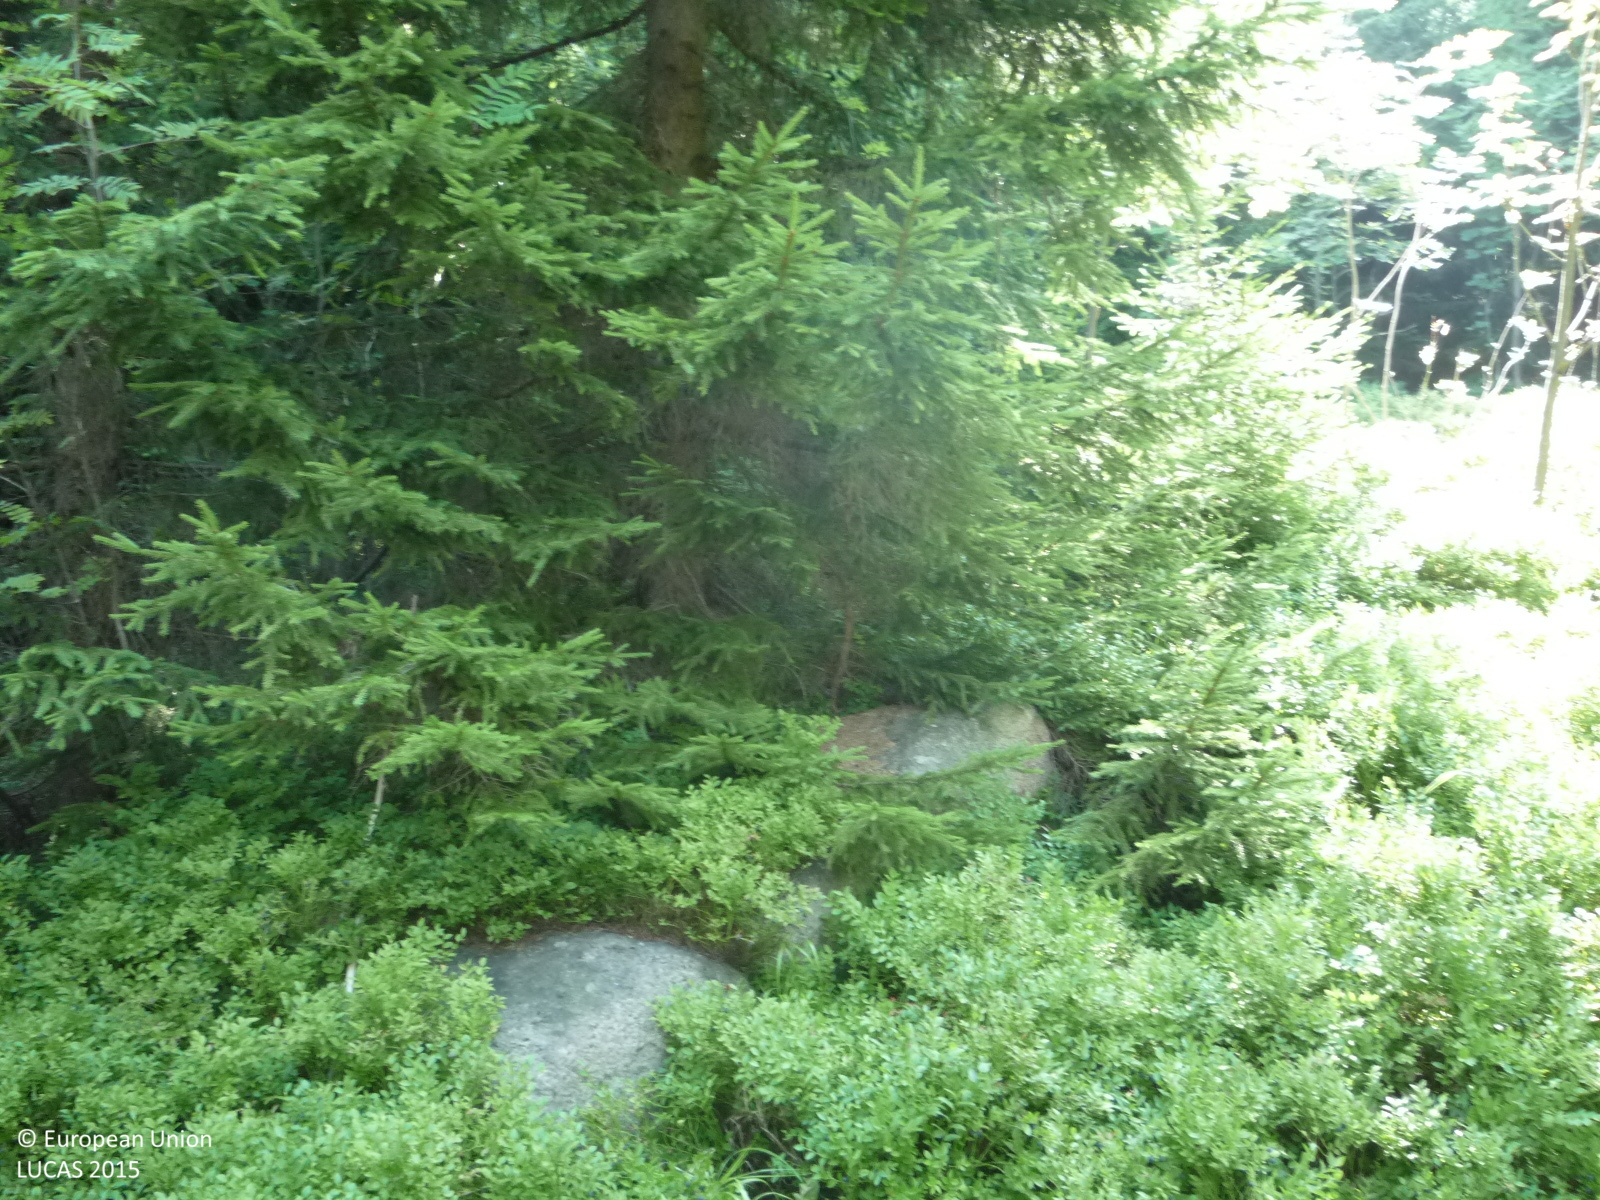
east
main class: Woodland
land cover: Spruce dominated coniferous woodland
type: hemiboreal forest and nemoral coniferous forest and mixed broadleaved-coniferous forest
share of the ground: > 75 %
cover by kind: coniferous forest trees 80 %, herbaceous plants 10 %, broadleaved forest trees 5 %, shrubs 5 %
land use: Forestry
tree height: > 5 m
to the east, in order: Spruce dominated coniferous woodland; Tracks; Spruce dominated coniferous woodland
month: August
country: CZ
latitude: 50.7130
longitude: 15.2293
